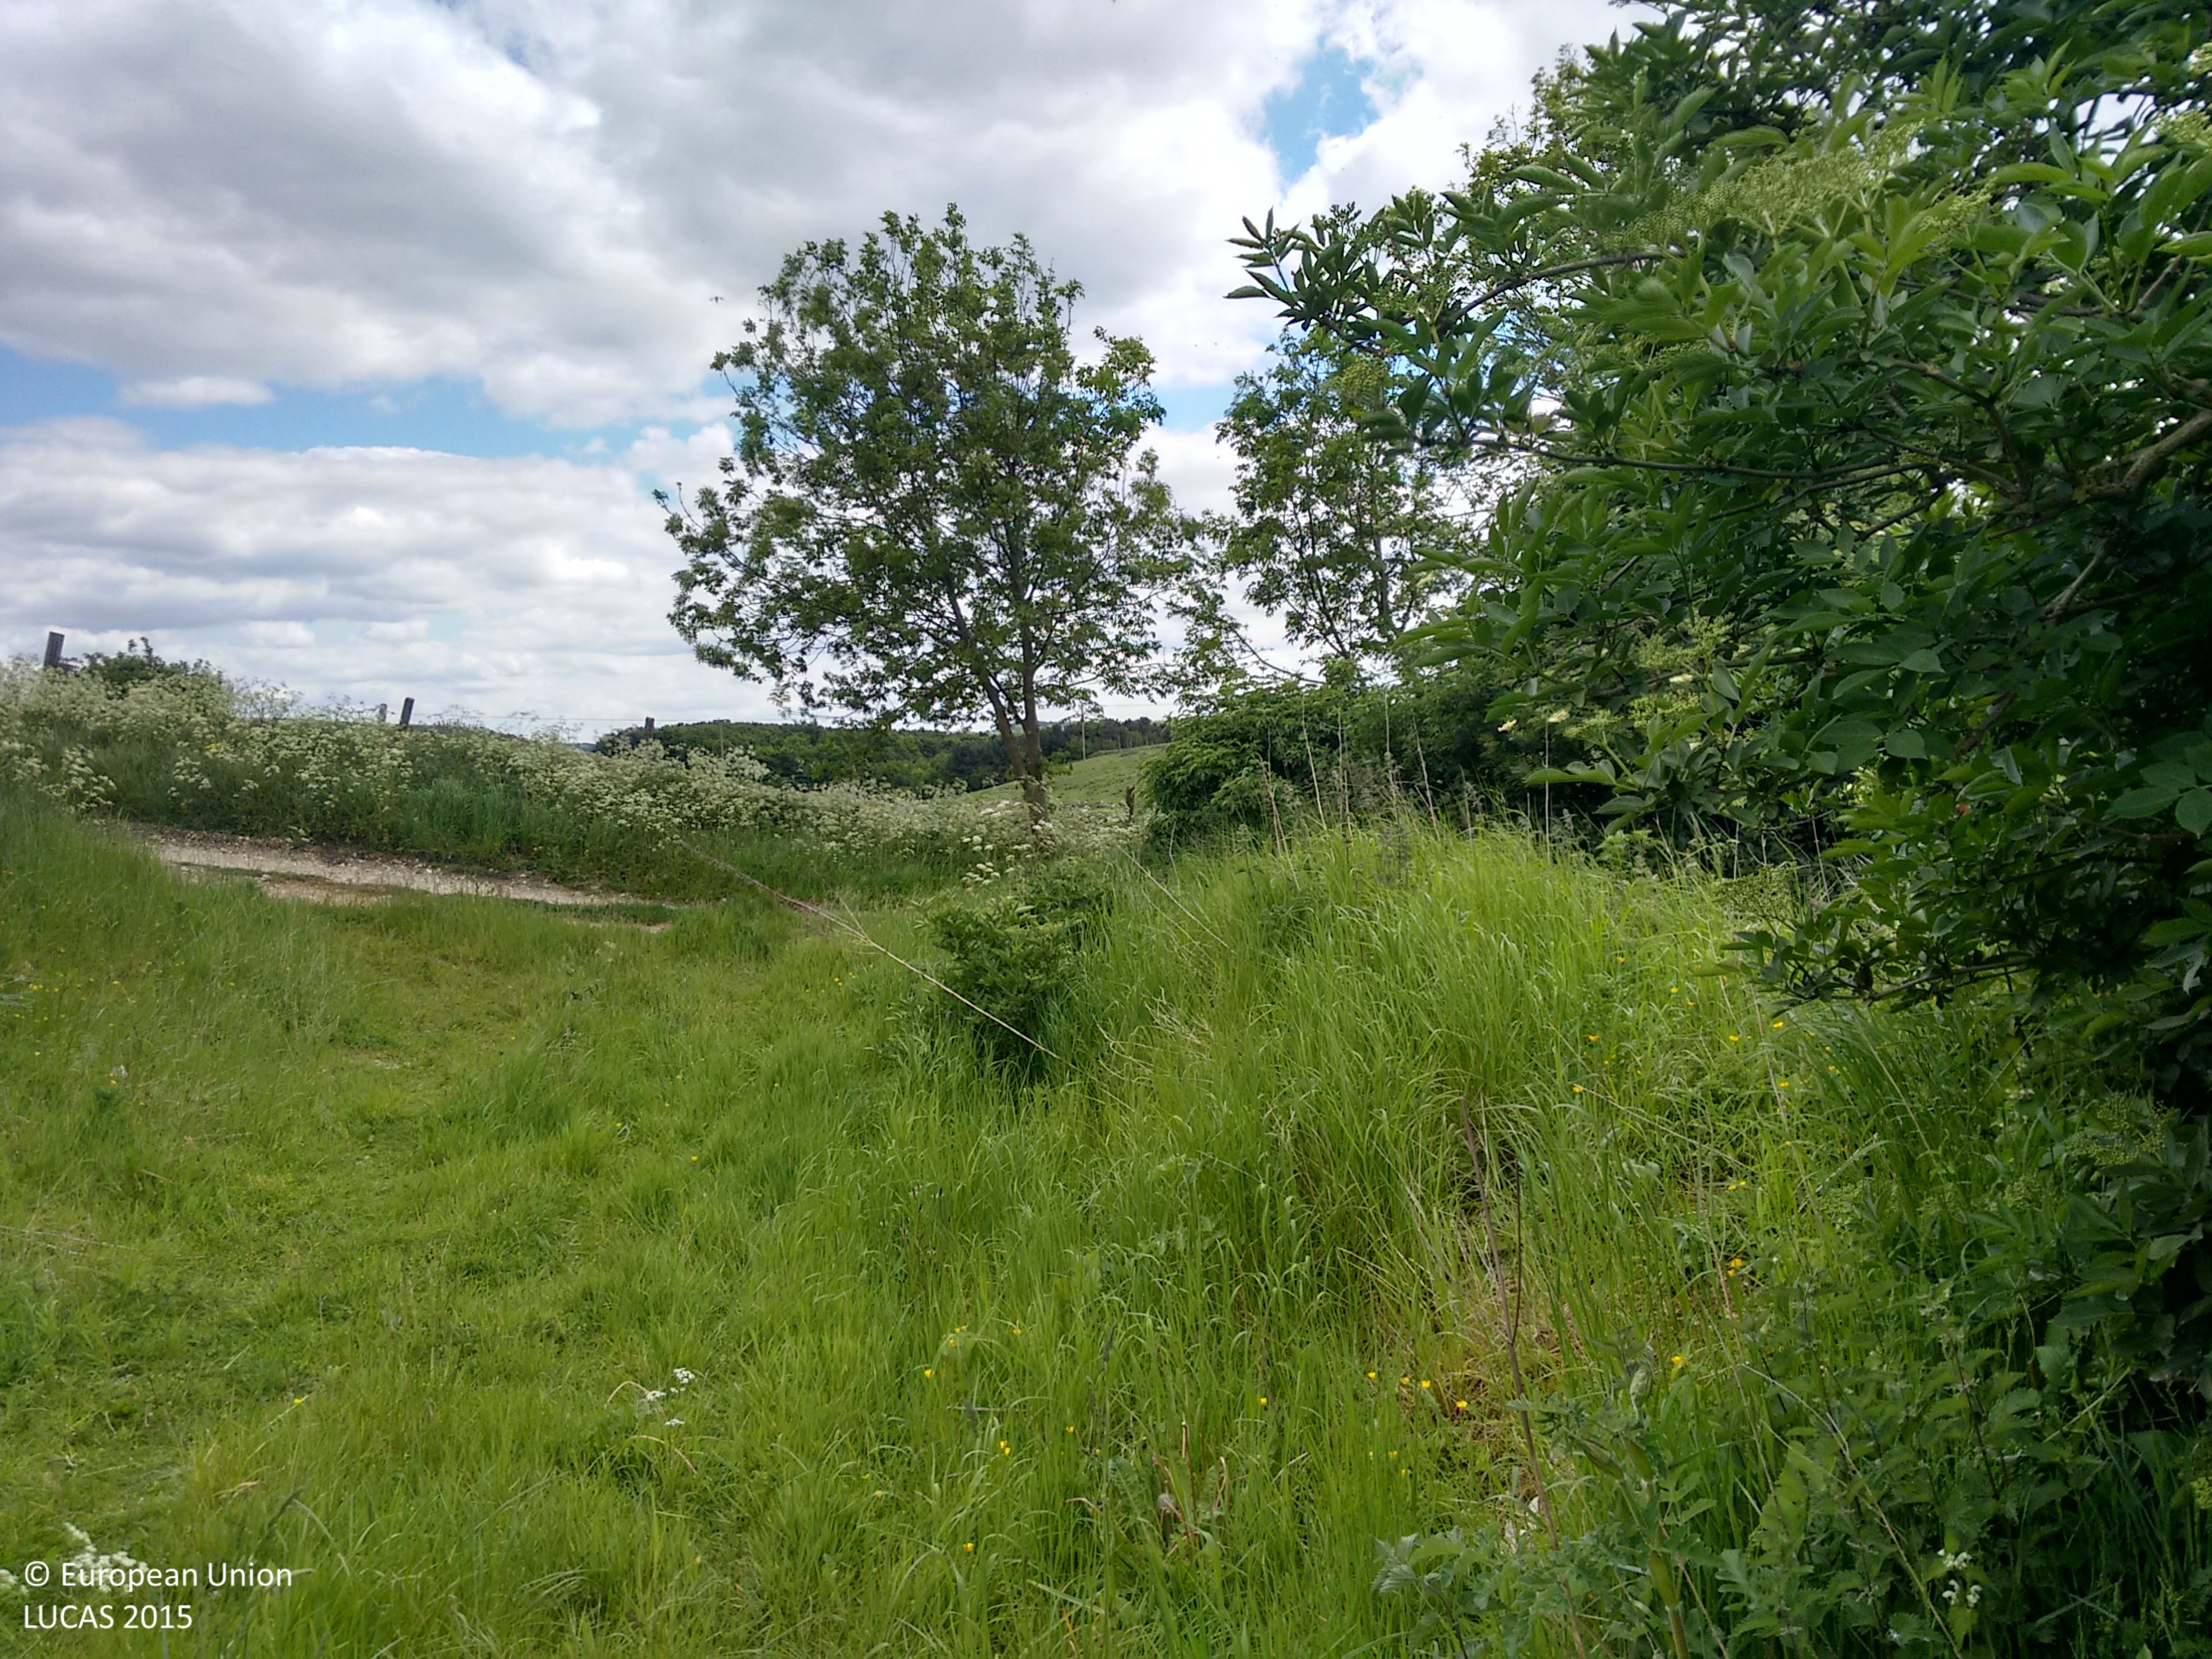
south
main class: Grassland
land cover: Spontaneously vegetated surfaces
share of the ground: > 75 %
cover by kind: herbaceous plants 100 %
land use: Agriculture (excluding fallow land and kitchen gardens)
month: June
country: GB
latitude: 53.4976
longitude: -0.1788
